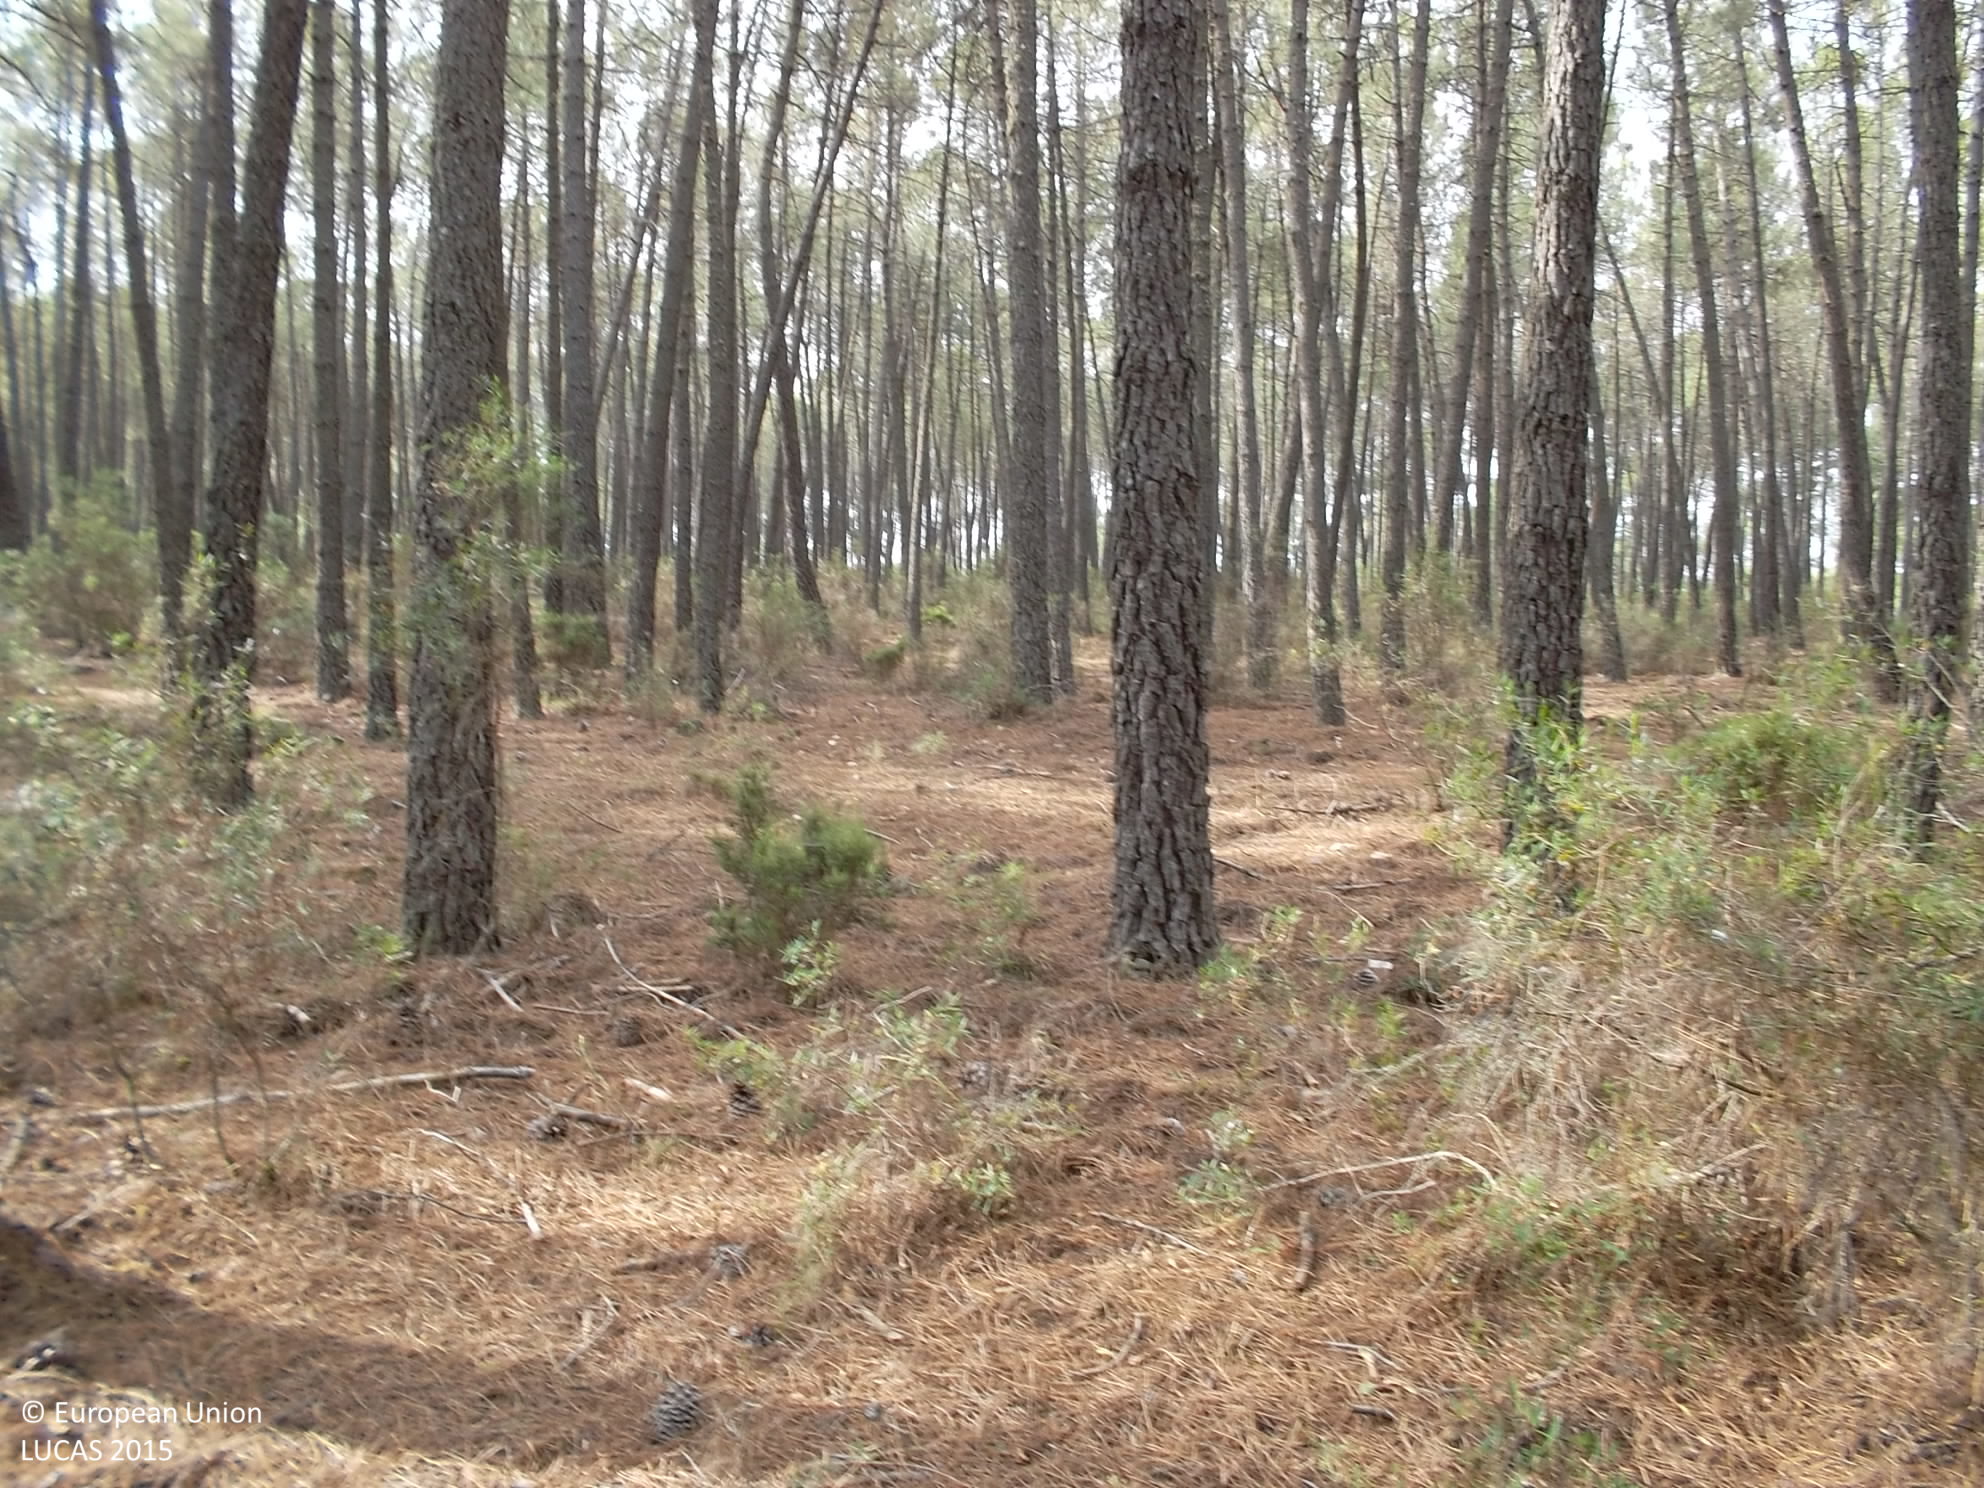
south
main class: Woodland
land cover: Pine dominated coniferous woodland
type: coniferous forest of the mediterranean region
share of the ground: > 75 %
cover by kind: coniferous forest trees 80 %, broadleaved forest trees 20 %
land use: Forestry
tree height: > 5 m
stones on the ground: 10 - 25 %
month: June
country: ES
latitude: 39.1721
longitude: -4.8166
